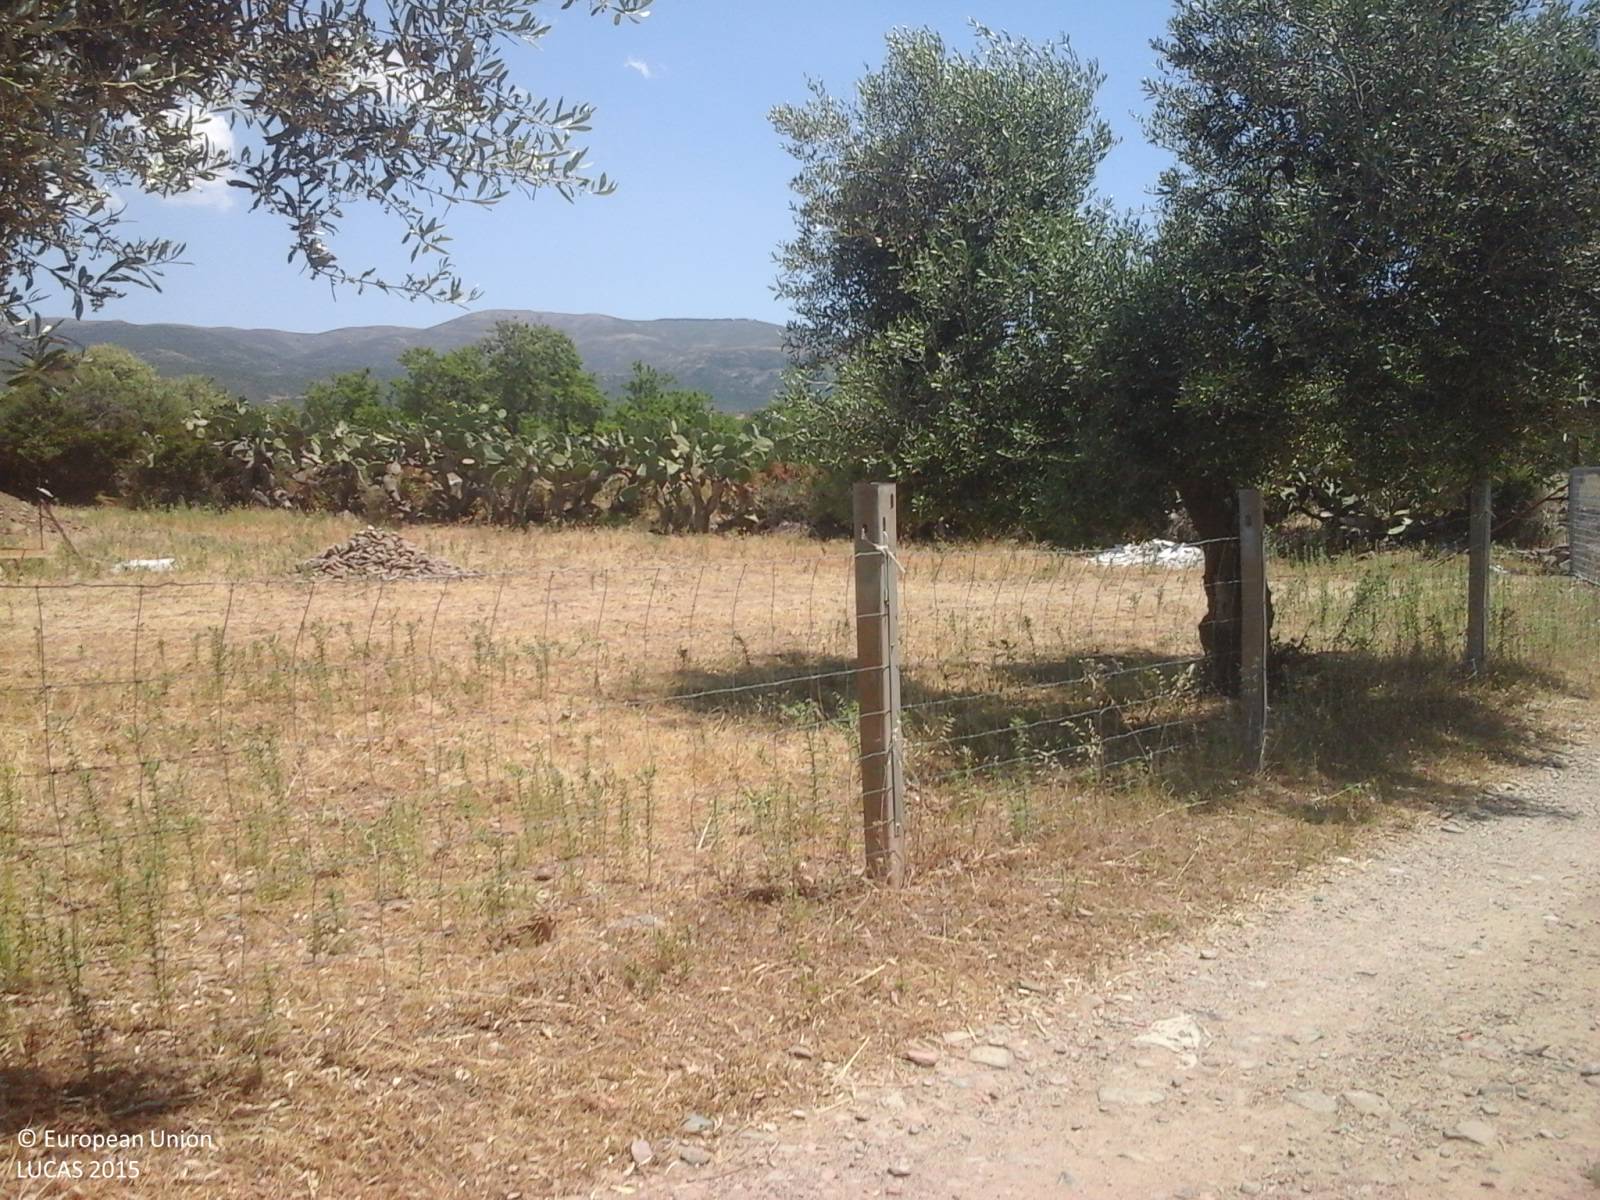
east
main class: Cropland
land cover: Olive groves
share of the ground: > 75 %
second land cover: Grassland without tree/shrub cover
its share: > 75 %
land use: Agriculture (excluding fallow land and kitchen gardens)
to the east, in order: Olive groves; Grassland without tree/shrub cover; Fences; Tracks; Fences; Abandoned hedges; Grassland without tree/shrub cover; Electric lines; Olive groves
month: June
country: IT
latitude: 39.3766
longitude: 9.2039
